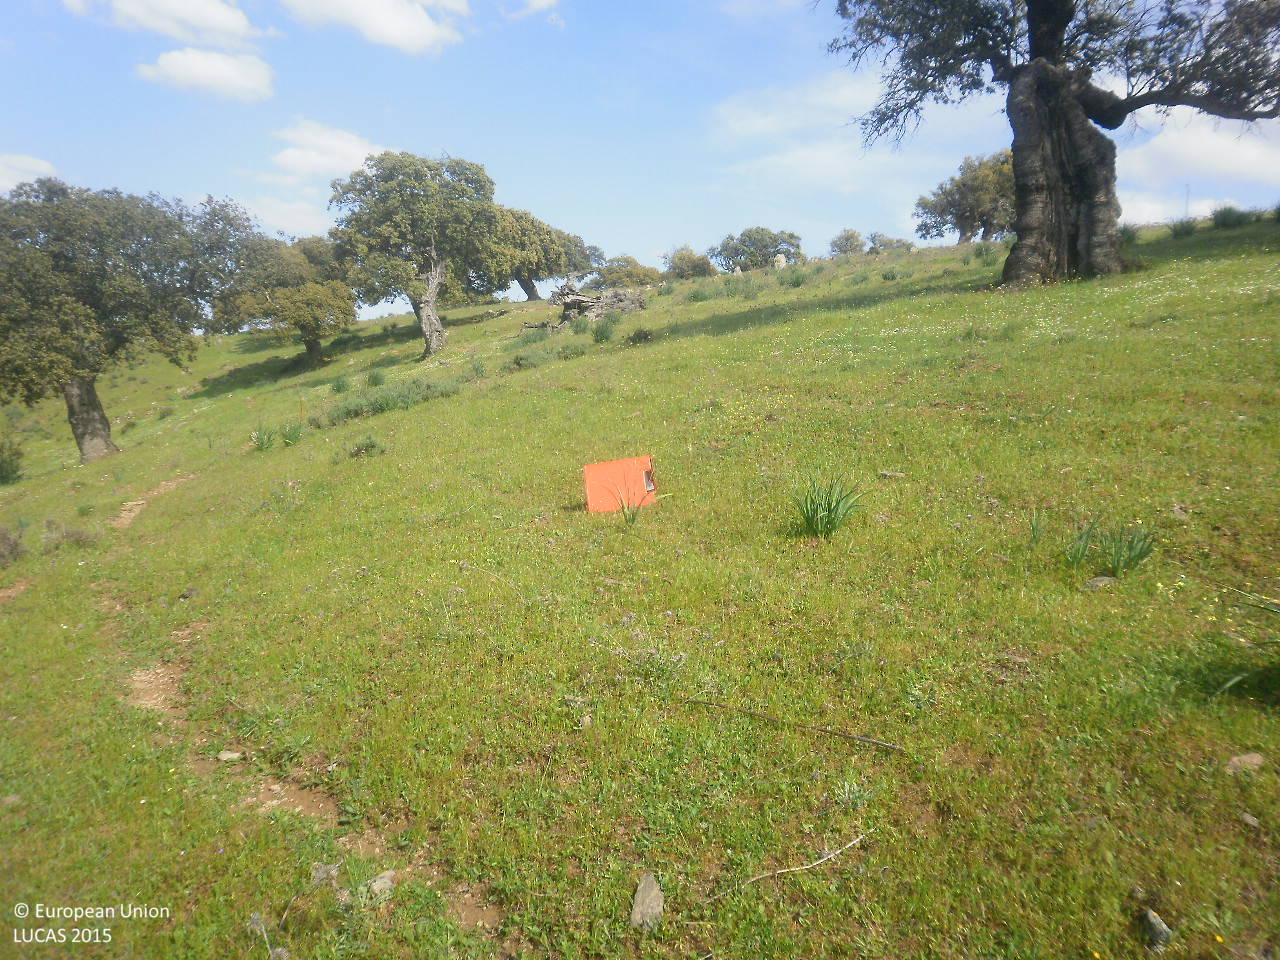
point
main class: Grassland
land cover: Grassland with sparse tree/shrub cover
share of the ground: > 75 %
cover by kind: herbaceous plants 85 %, shrubs 10 %, broadleaved forest trees 5 %
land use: Agriculture (excluding fallow land and kitchen gardens)
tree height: > 5 m
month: April
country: ES
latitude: 38.9876
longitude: -5.1733
